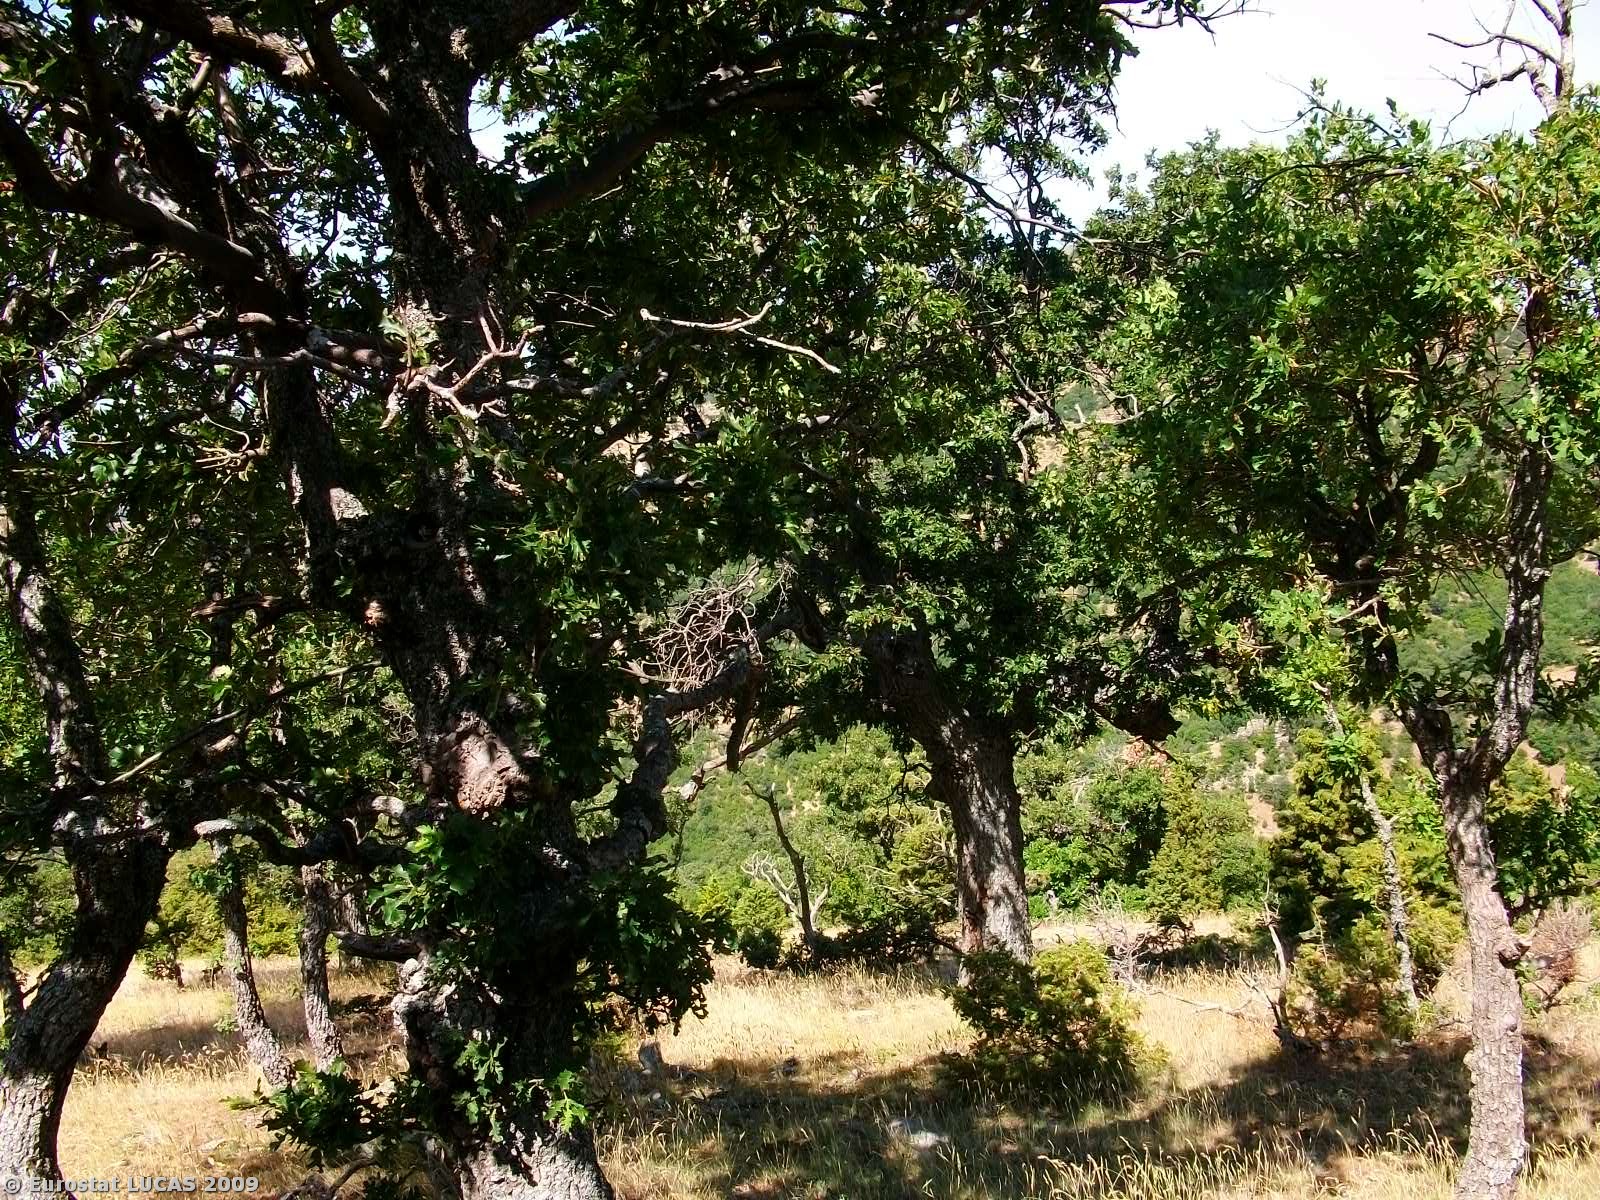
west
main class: Woodland
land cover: Broadleaved woodland
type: thermophilous deciduous forest
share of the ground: > 75 %
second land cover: Grassland with sparse tree/shrub cover
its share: > 75 %
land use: Agriculture (excluding fallow land and kitchen gardens)
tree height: > 5 m
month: June
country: GR
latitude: 41.1403
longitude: 25.8453
